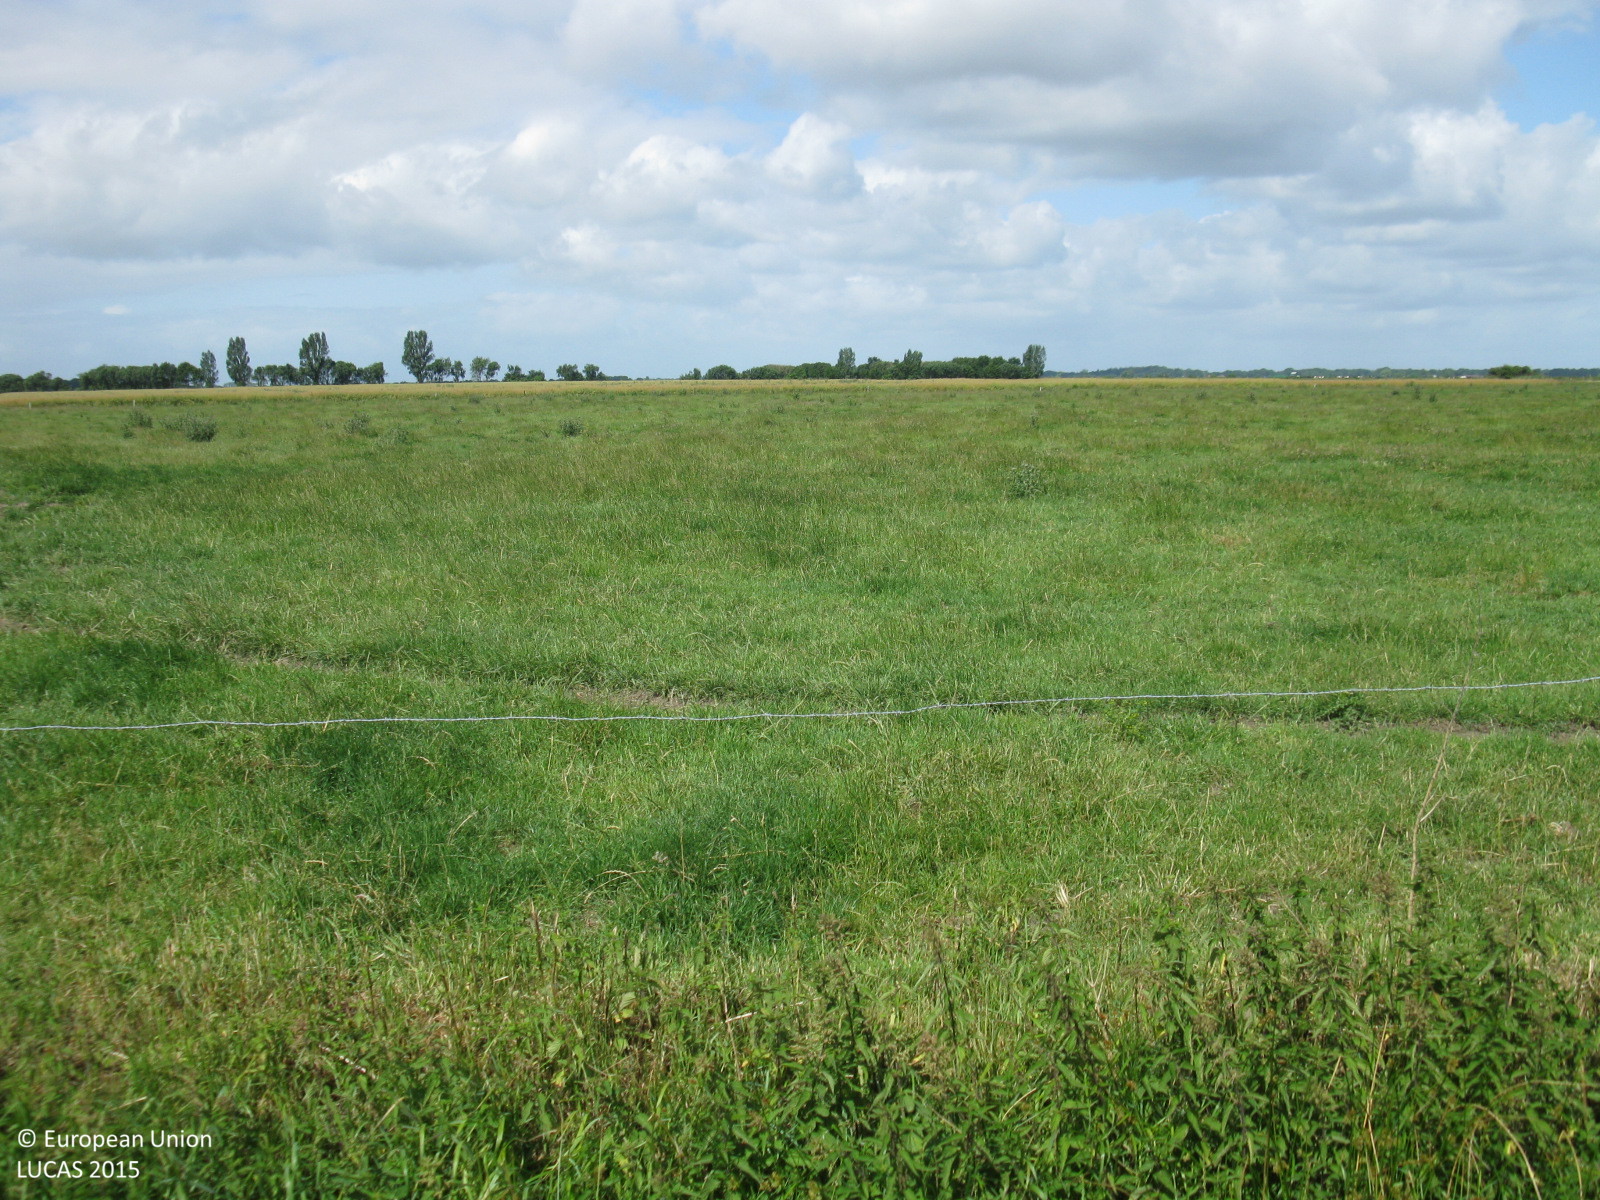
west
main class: Grassland
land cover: Grassland without tree/shrub cover
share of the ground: > 75 %
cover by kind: herbaceous plants 100 %
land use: Agriculture (excluding fallow land and kitchen gardens)
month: July
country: DE
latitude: 53.4743
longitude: 7.9366
